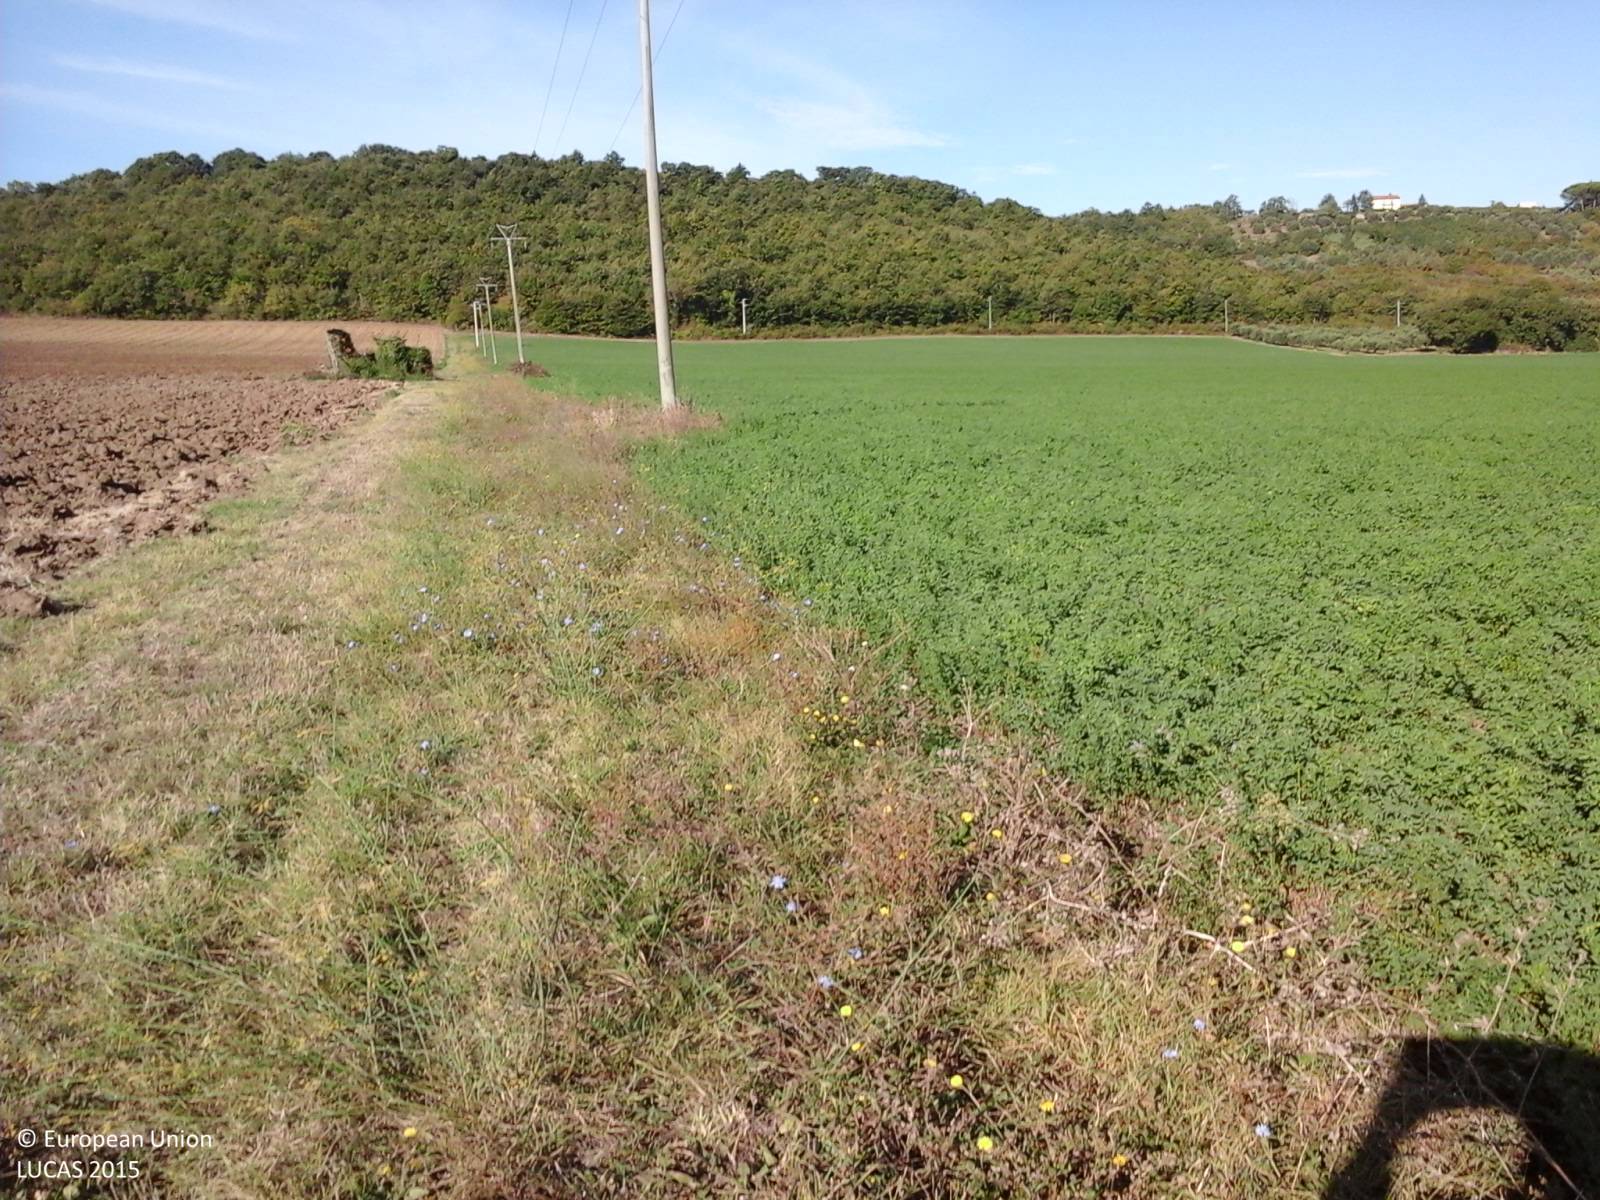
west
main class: Cropland
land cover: Lucerne
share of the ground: > 75 %
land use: Agriculture (excluding fallow land and kitchen gardens)
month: September
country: IT
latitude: 42.5388
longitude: 12.2451
